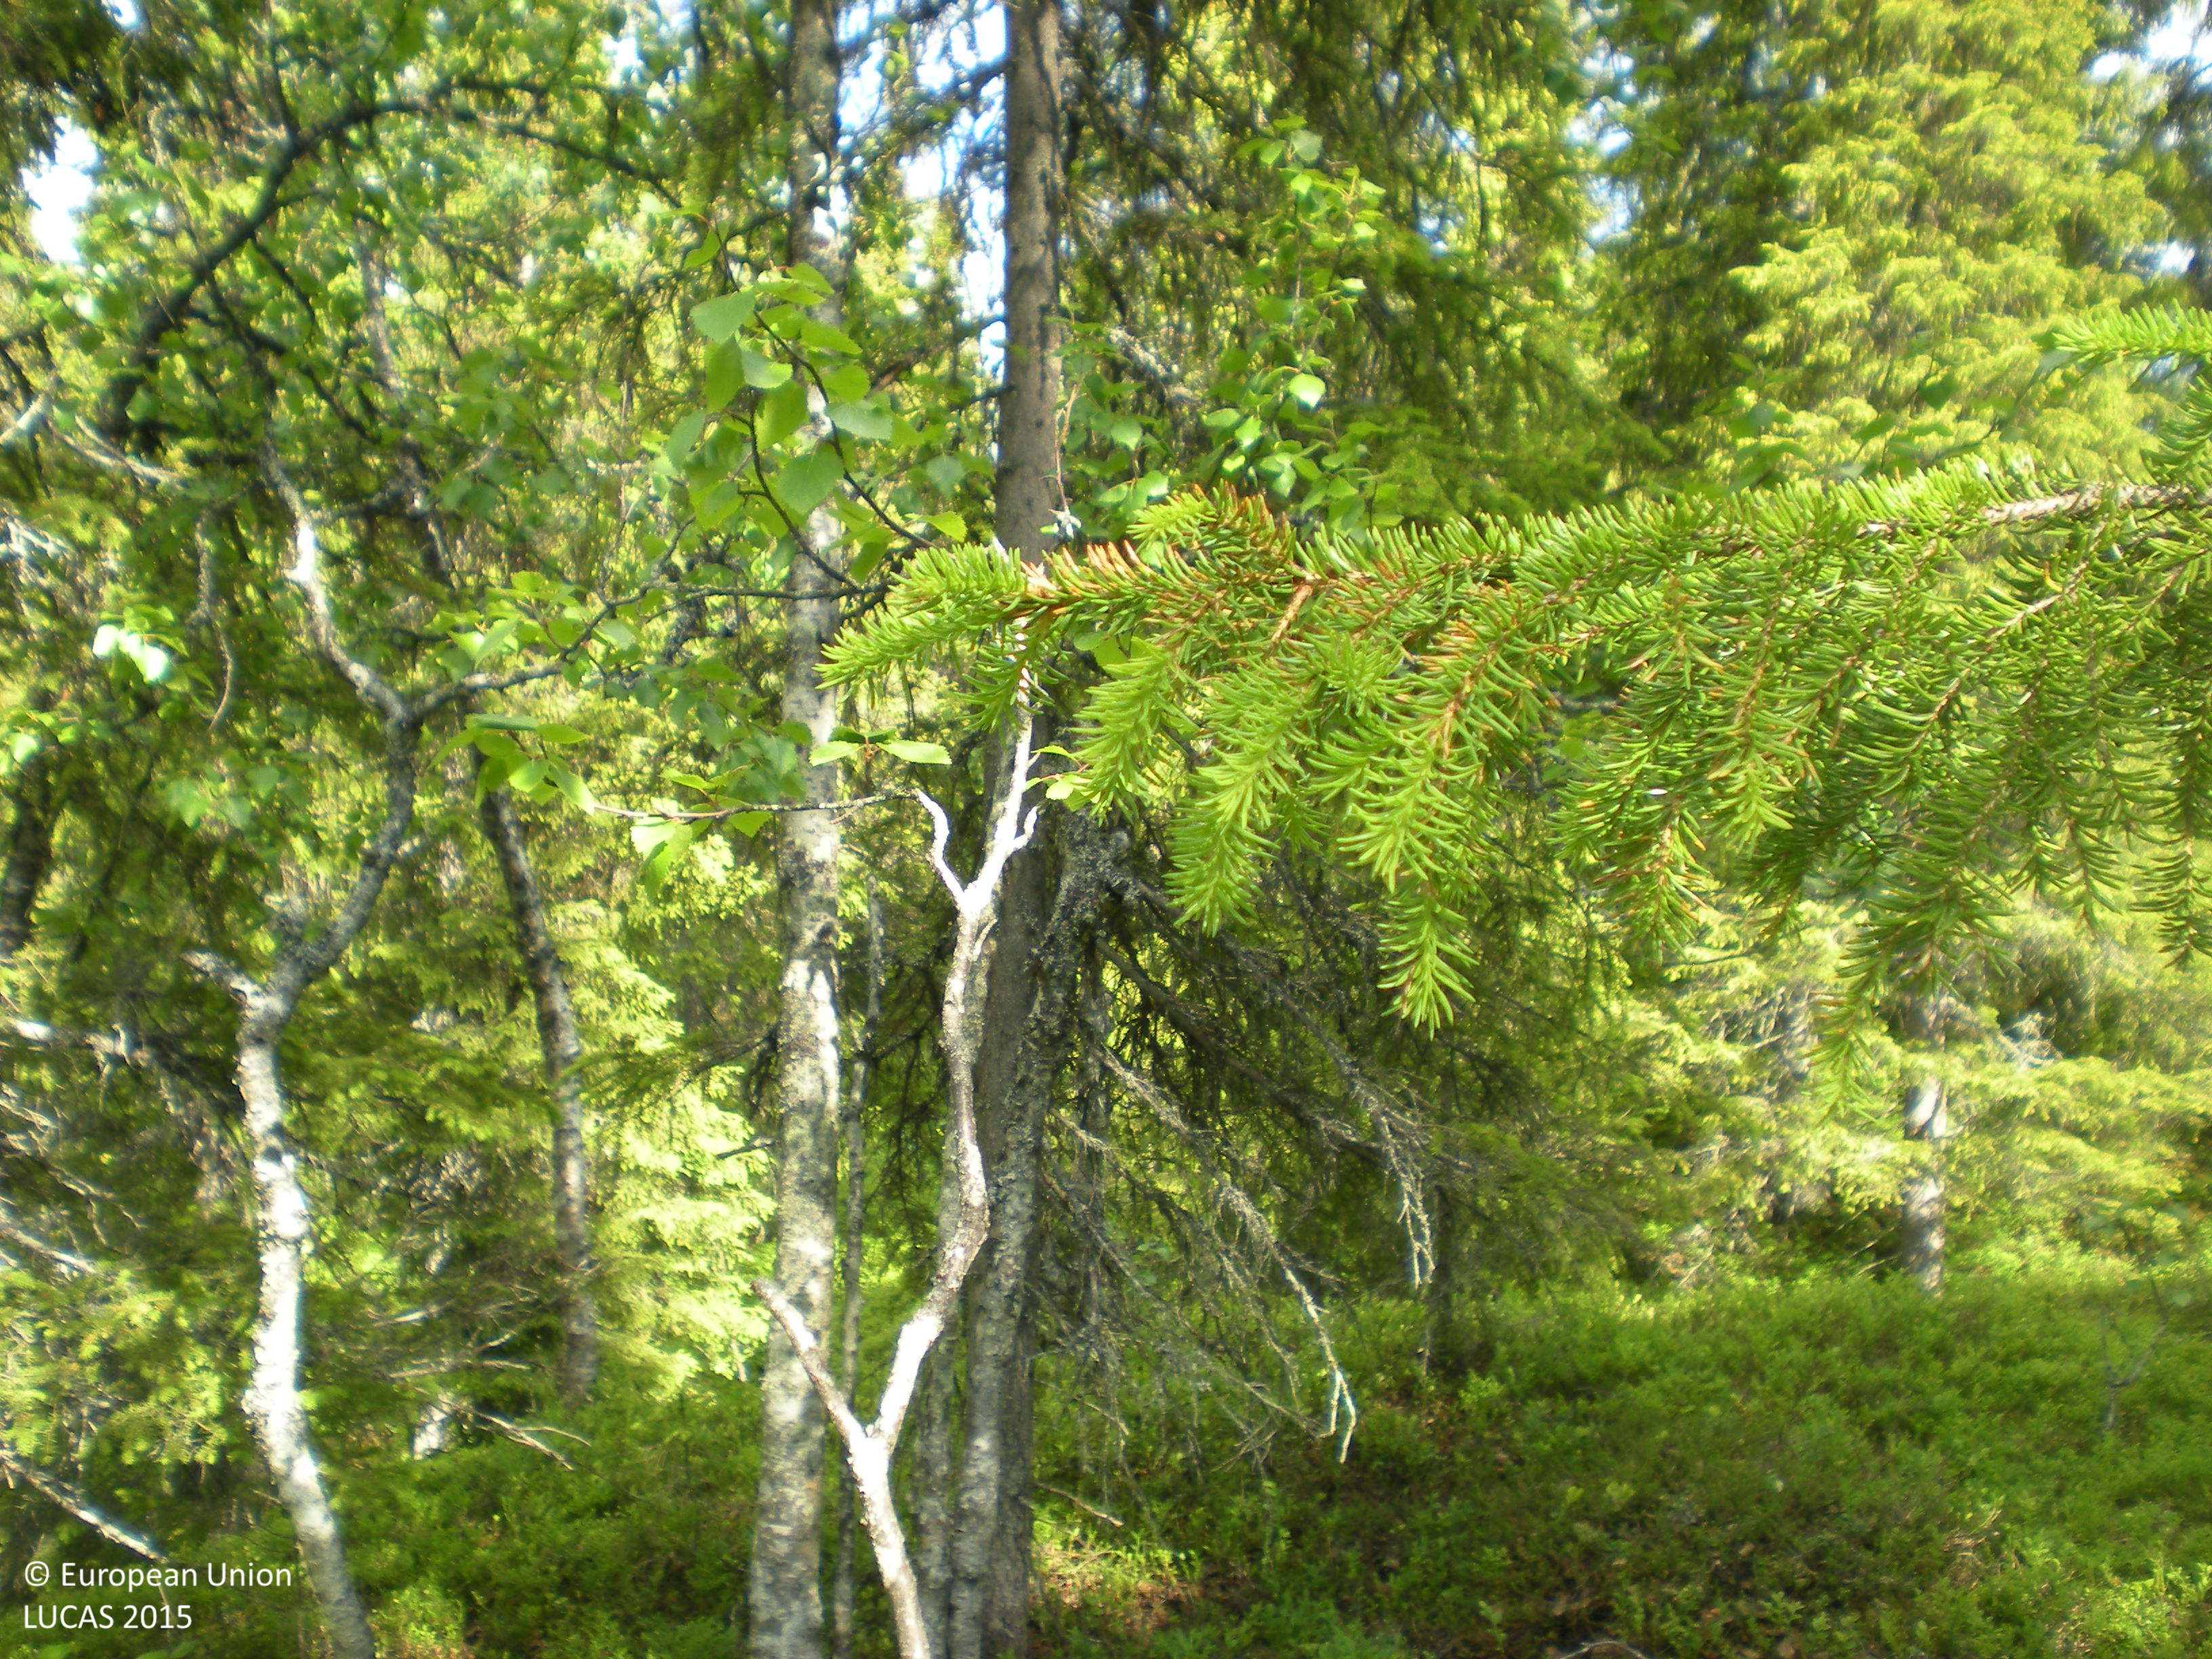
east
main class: Woodland
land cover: Spruce dominated mixed woodland
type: boreal forest
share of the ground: 50 - 75 %
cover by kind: coniferous forest trees 35 %, broadleaved forest trees 30 %, shrubs 25 %, lichens and mosses 10 %
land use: Forestry
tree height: > 5 m
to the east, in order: Spruce dominated mixed woodland; Spruce dominated coniferous woodland; Spruce dominated mixed woodland
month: July
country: SE
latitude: 65.5558
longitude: 16.8690
